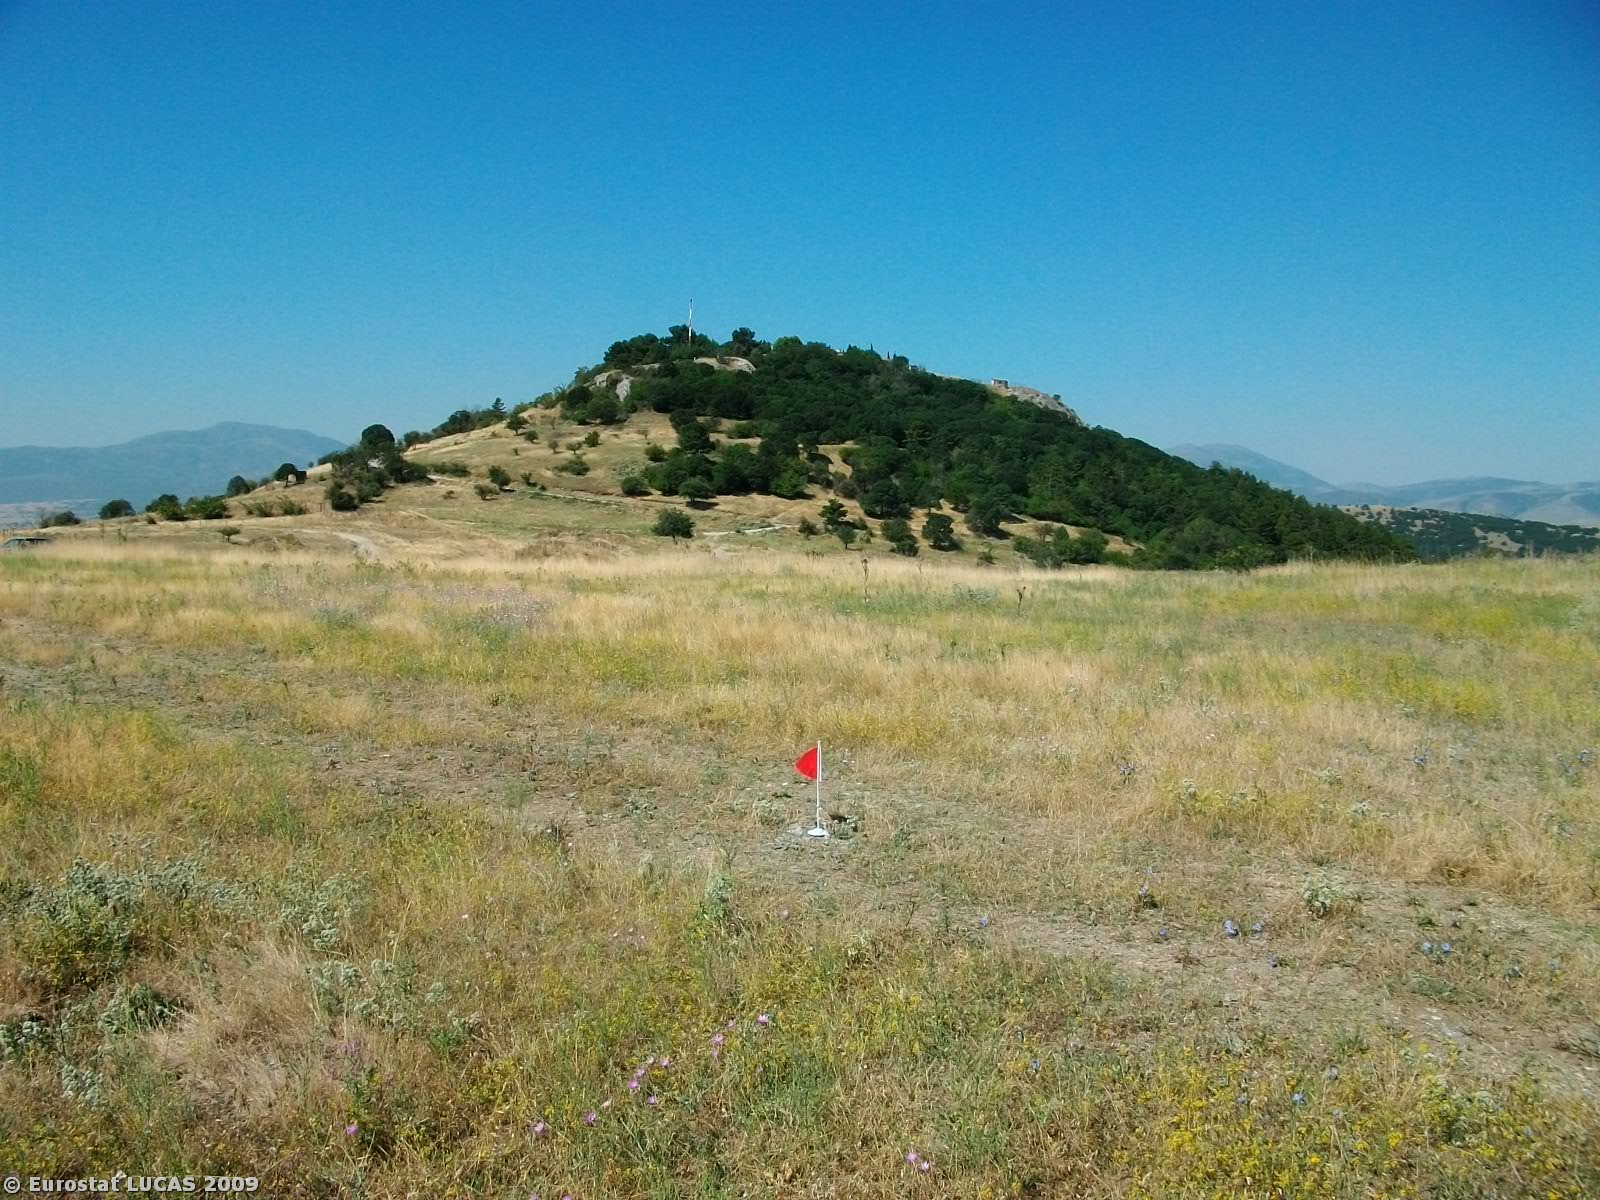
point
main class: Artificial land
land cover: Non built-up linear features
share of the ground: > 75 %
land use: Road transport
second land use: Agriculture (excluding fallow land and kitchen gardens)
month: July
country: GR
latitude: 40.3324
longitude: 21.8456
